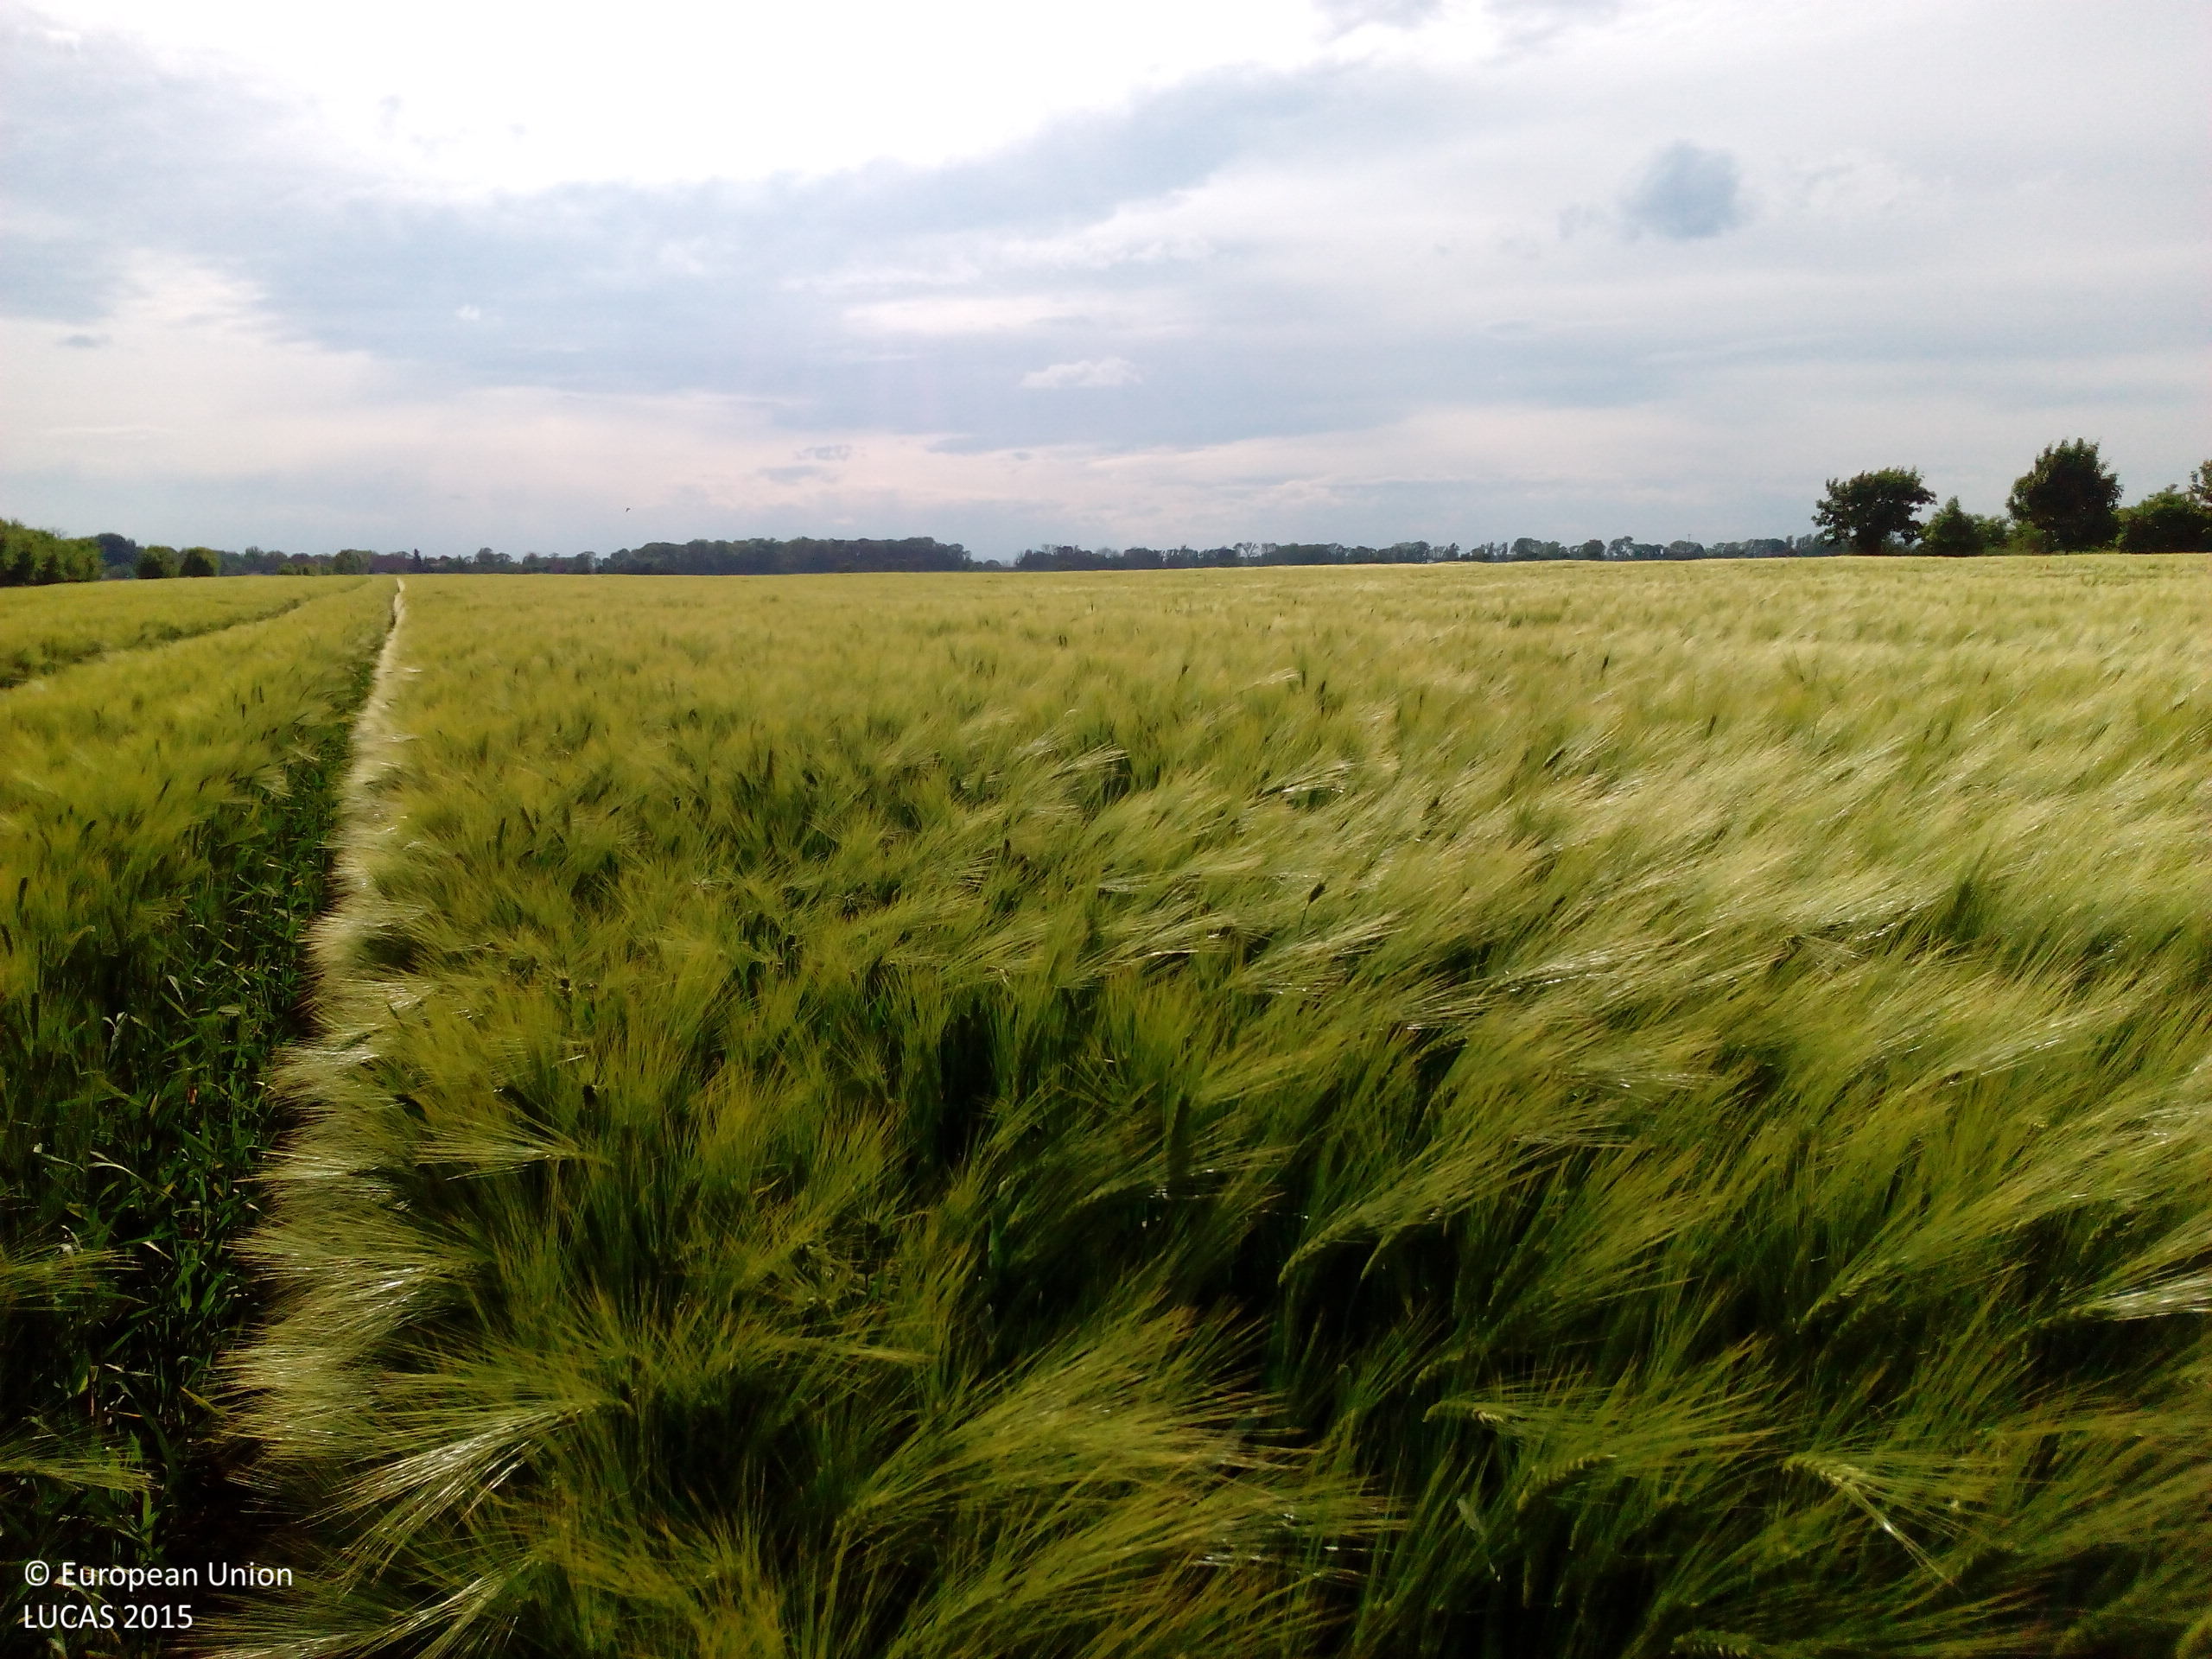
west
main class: Cropland
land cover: Barley
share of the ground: > 75 %
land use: Agriculture (excluding fallow land and kitchen gardens)
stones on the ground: < 10 %
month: May
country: DE
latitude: 51.7116
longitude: 12.0982
